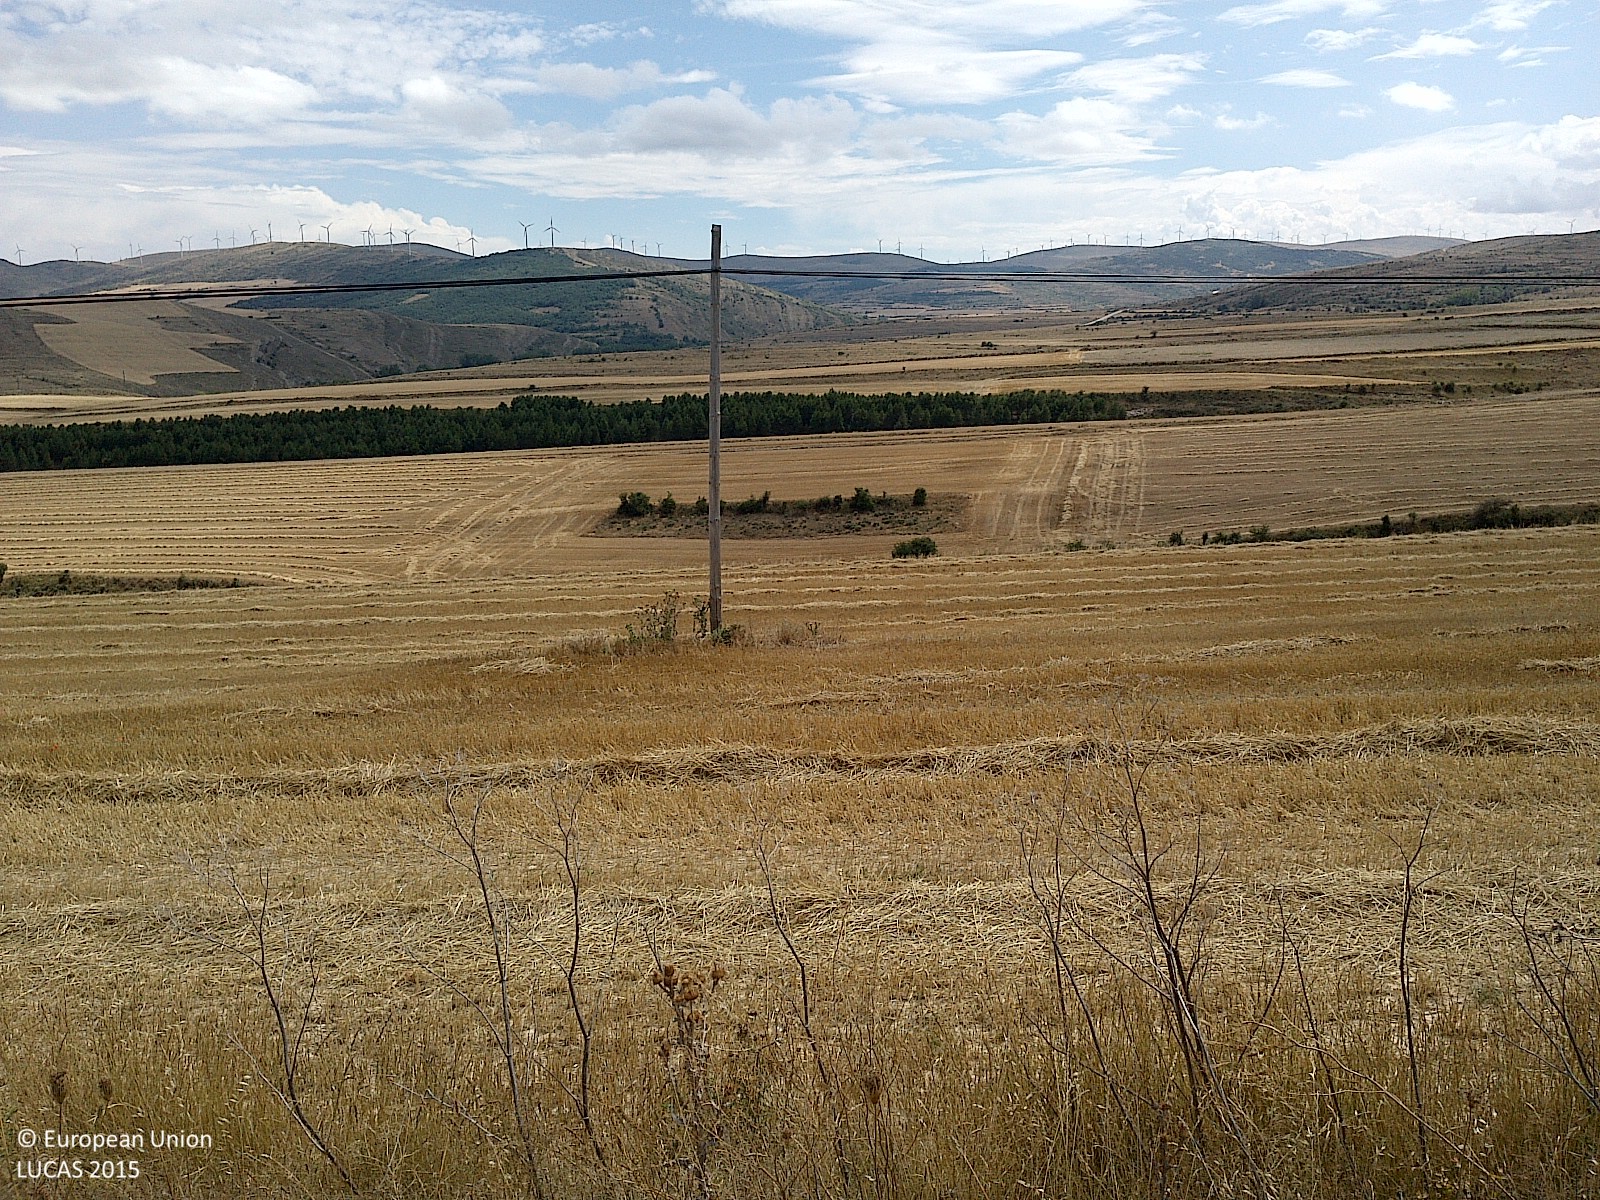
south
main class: Grassland
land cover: Grassland without tree/shrub cover
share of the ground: > 75 %
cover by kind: herbaceous plants 80 %, unconsolidated bare surface 15 %, shrubs 5 %
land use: Semi-natural and natural areas not in use
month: July
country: ES
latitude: 42.0173
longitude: -2.2470
